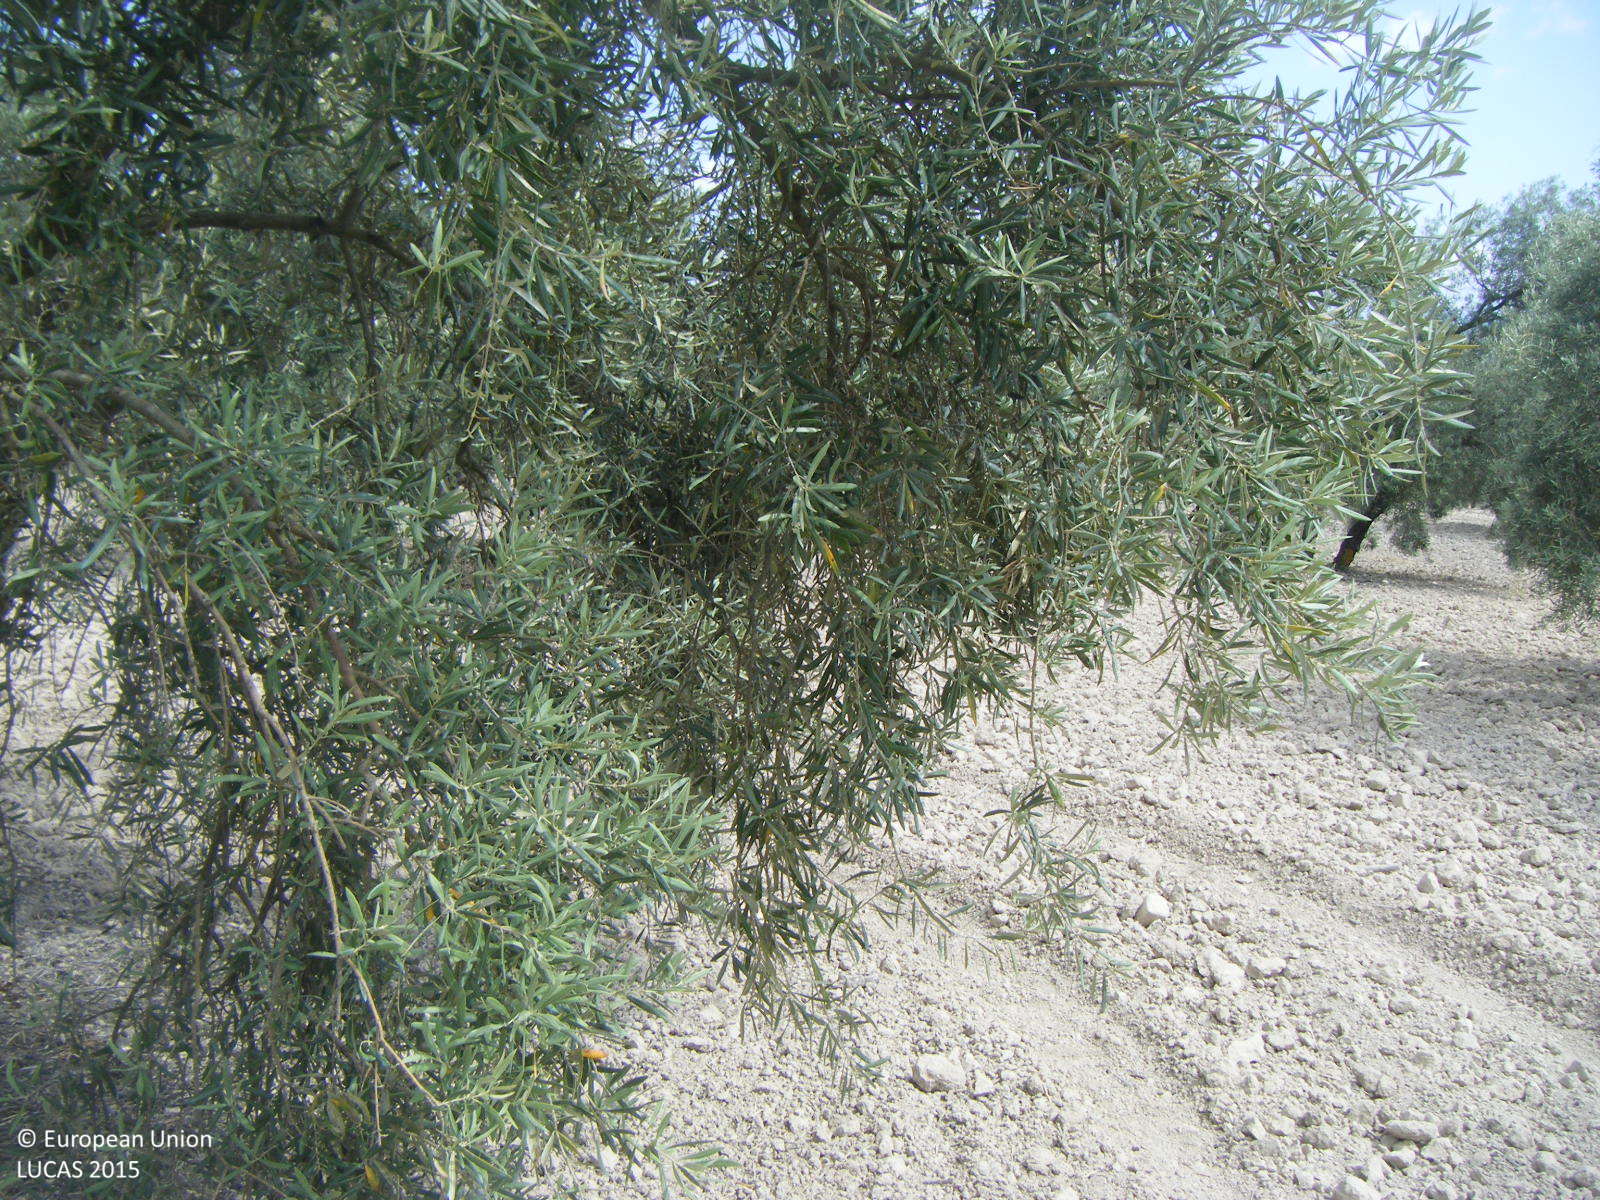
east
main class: Cropland
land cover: Olive groves
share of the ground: 10 - 25 %
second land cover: Other bare soil
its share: > 75 %
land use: Agriculture (excluding fallow land and kitchen gardens)
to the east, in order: Olive groves; Other bare soil
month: May
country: ES
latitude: 37.1356
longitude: -4.4401
